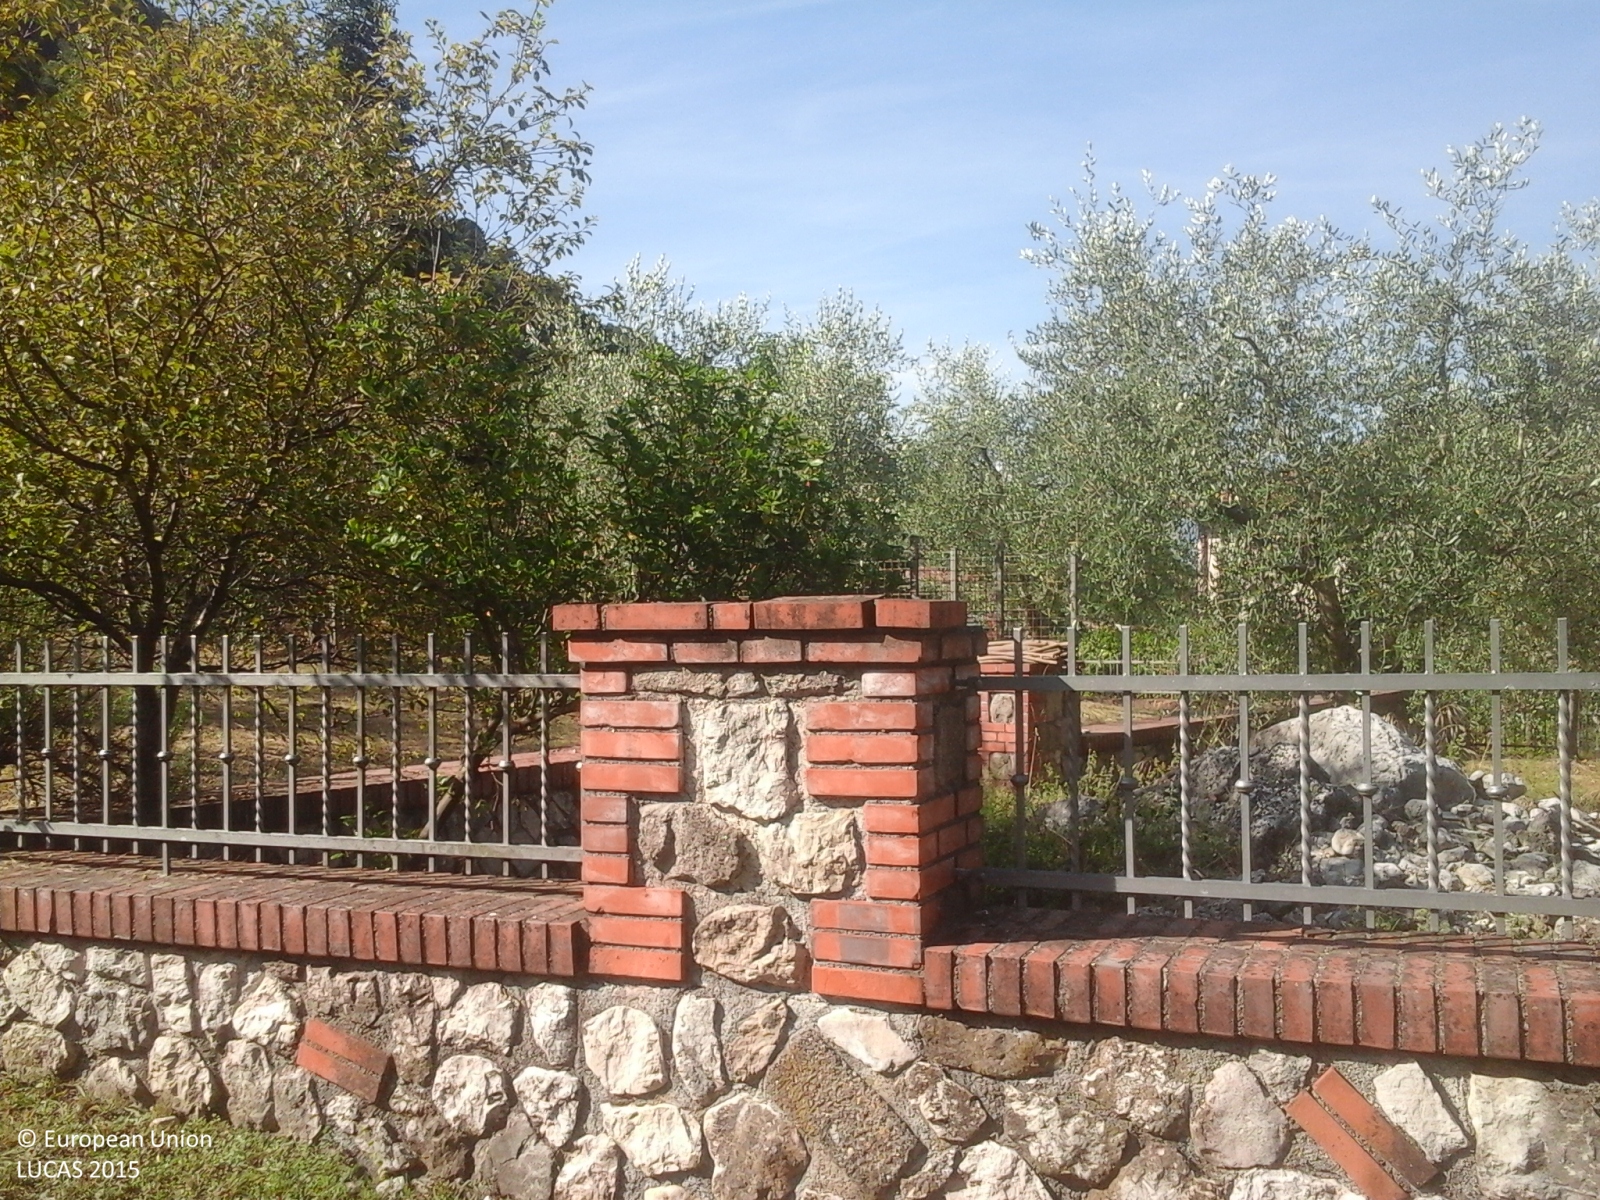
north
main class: Cropland
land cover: Olive groves
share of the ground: 50 - 75 %
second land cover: Grassland without tree/shrub cover
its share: > 75 %
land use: Kitchen garden
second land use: Residential
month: June
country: IT
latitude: 41.6085
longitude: 13.2156
